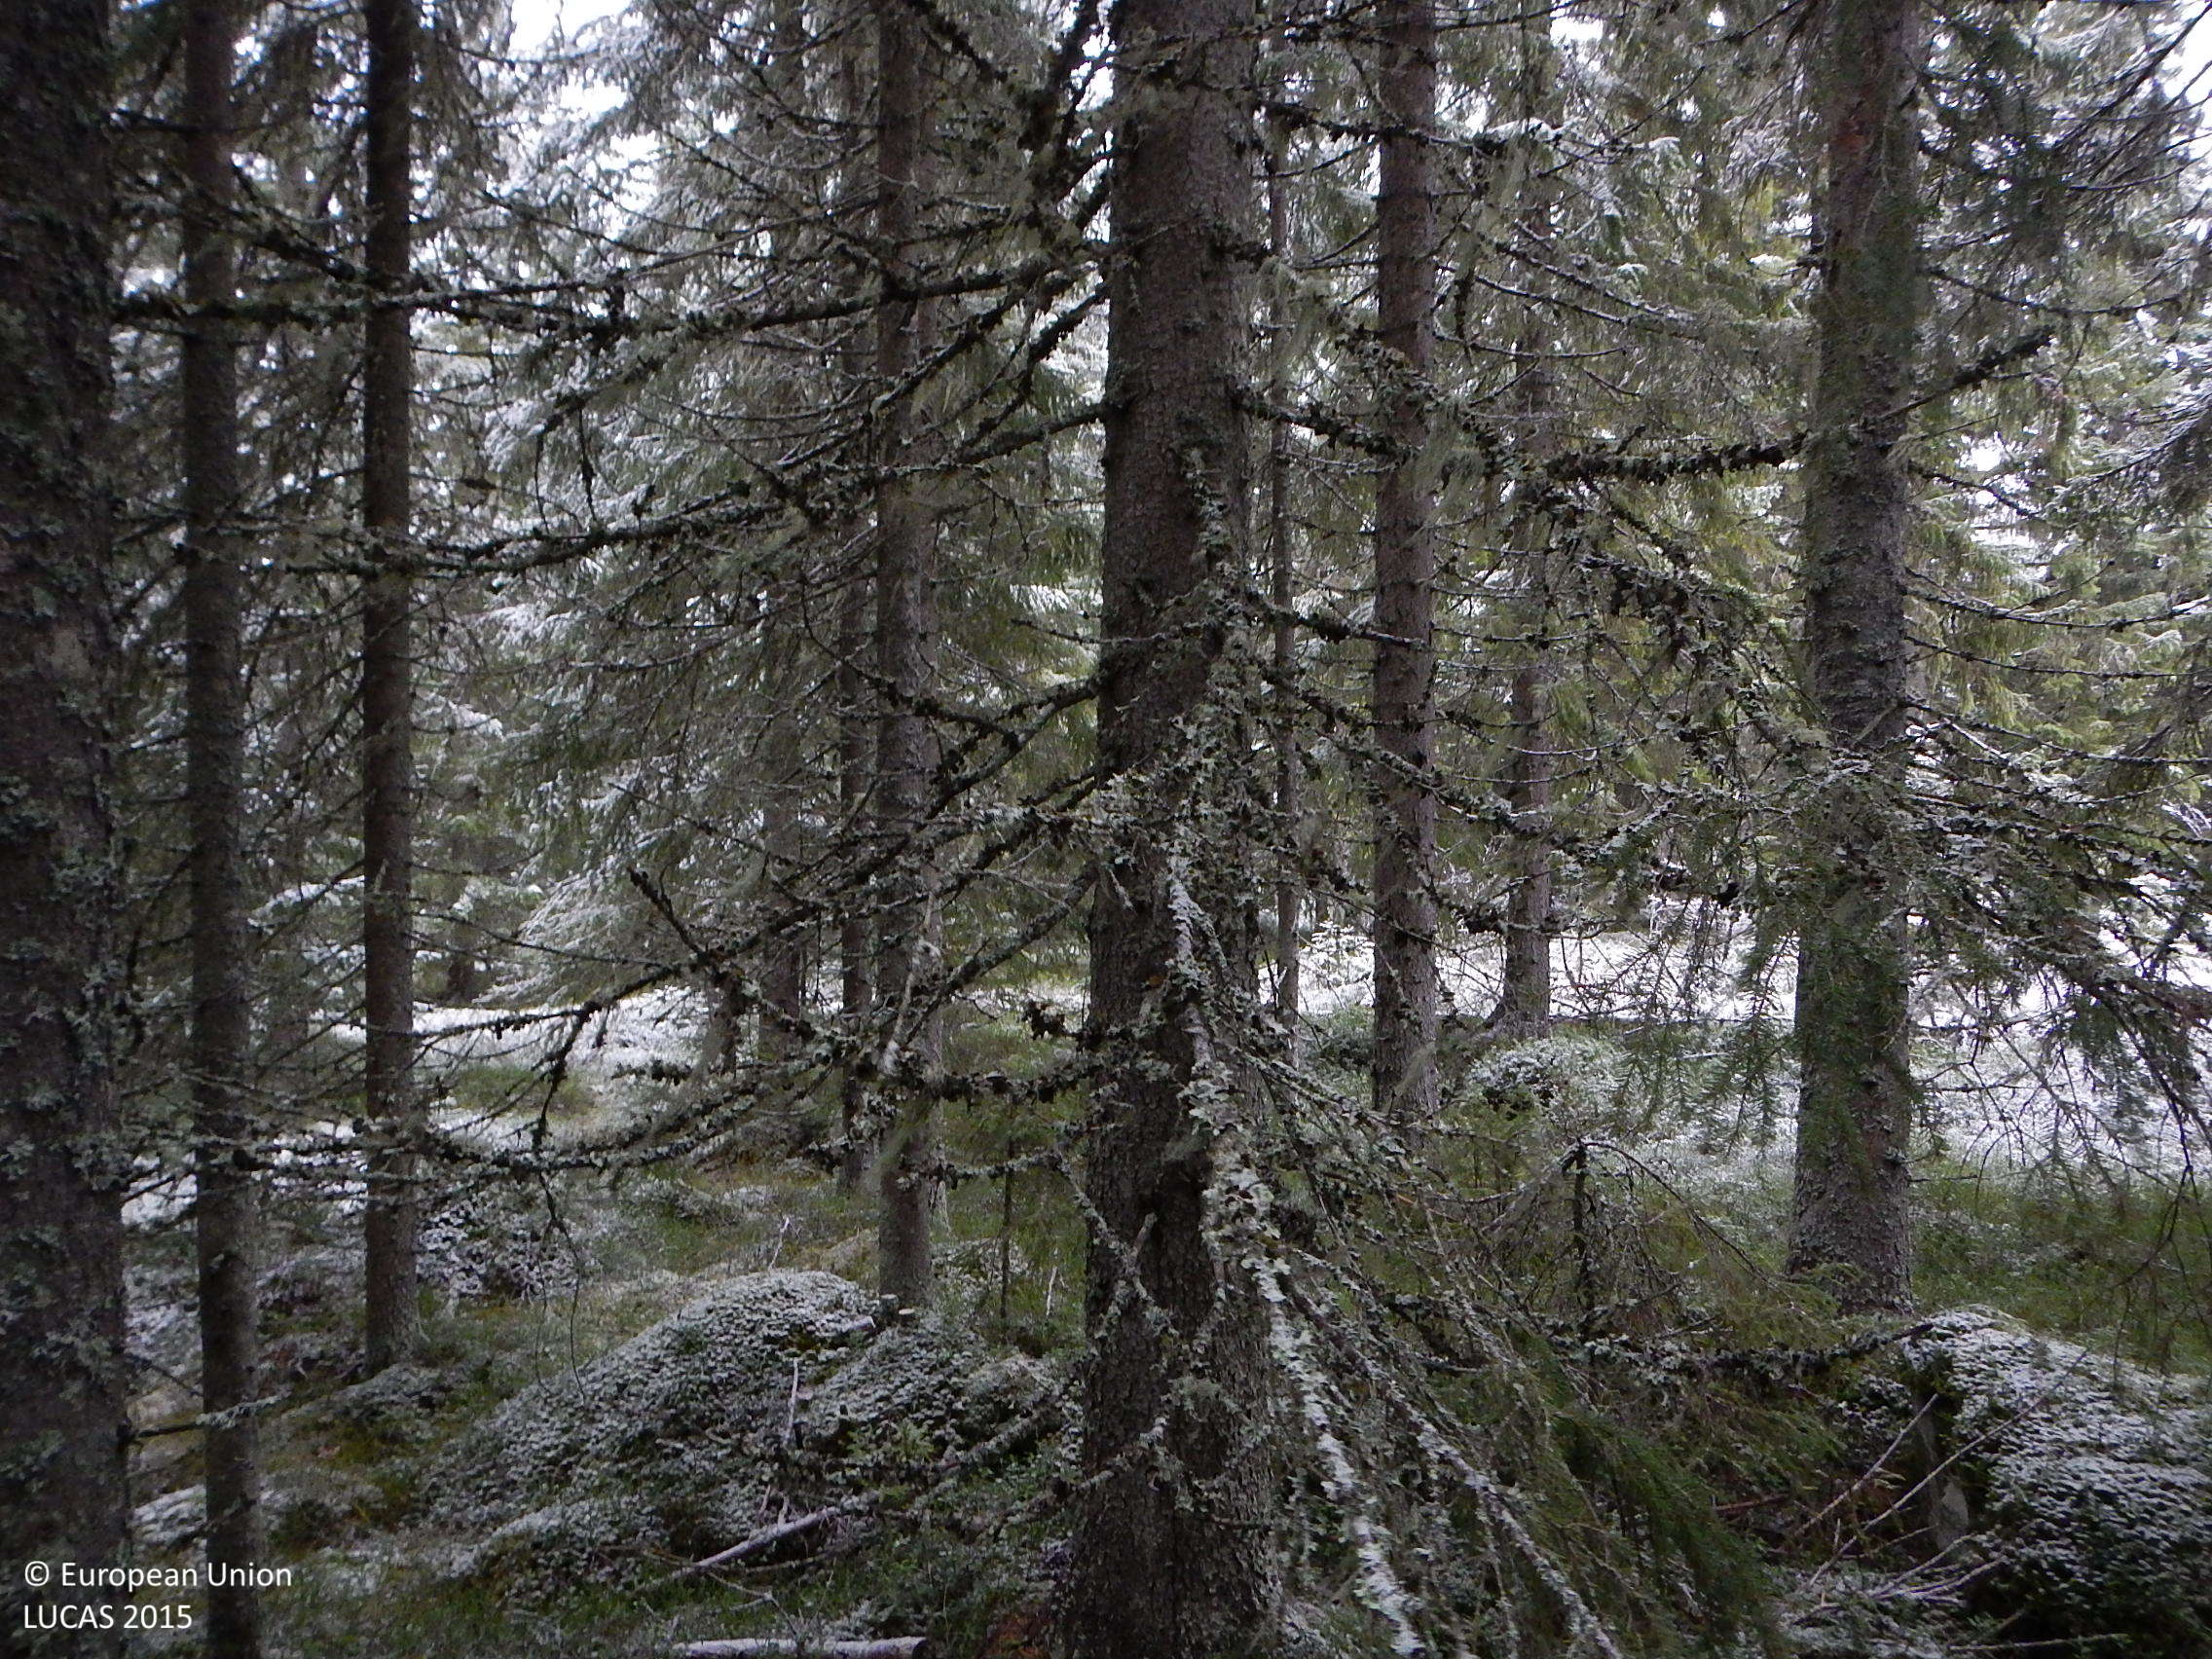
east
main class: Woodland
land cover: Spruce dominated coniferous woodland
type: boreal forest
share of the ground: > 75 %
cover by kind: coniferous forest trees 80 %, shrubs 10 %, lichens and mosses 10 %
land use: Forestry
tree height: > 5 m
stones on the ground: < 10 %
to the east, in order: Spruce dominated coniferous woodland; Tracks; Spruce dominated coniferous woodland; Other coniferous woodland; Ditches and canals; Paved roads, cycling and walking lanes; Other coniferous woodland; Spruce dominated coniferous woodland
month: November
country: SE
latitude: 61.7904
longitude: 15.4633
